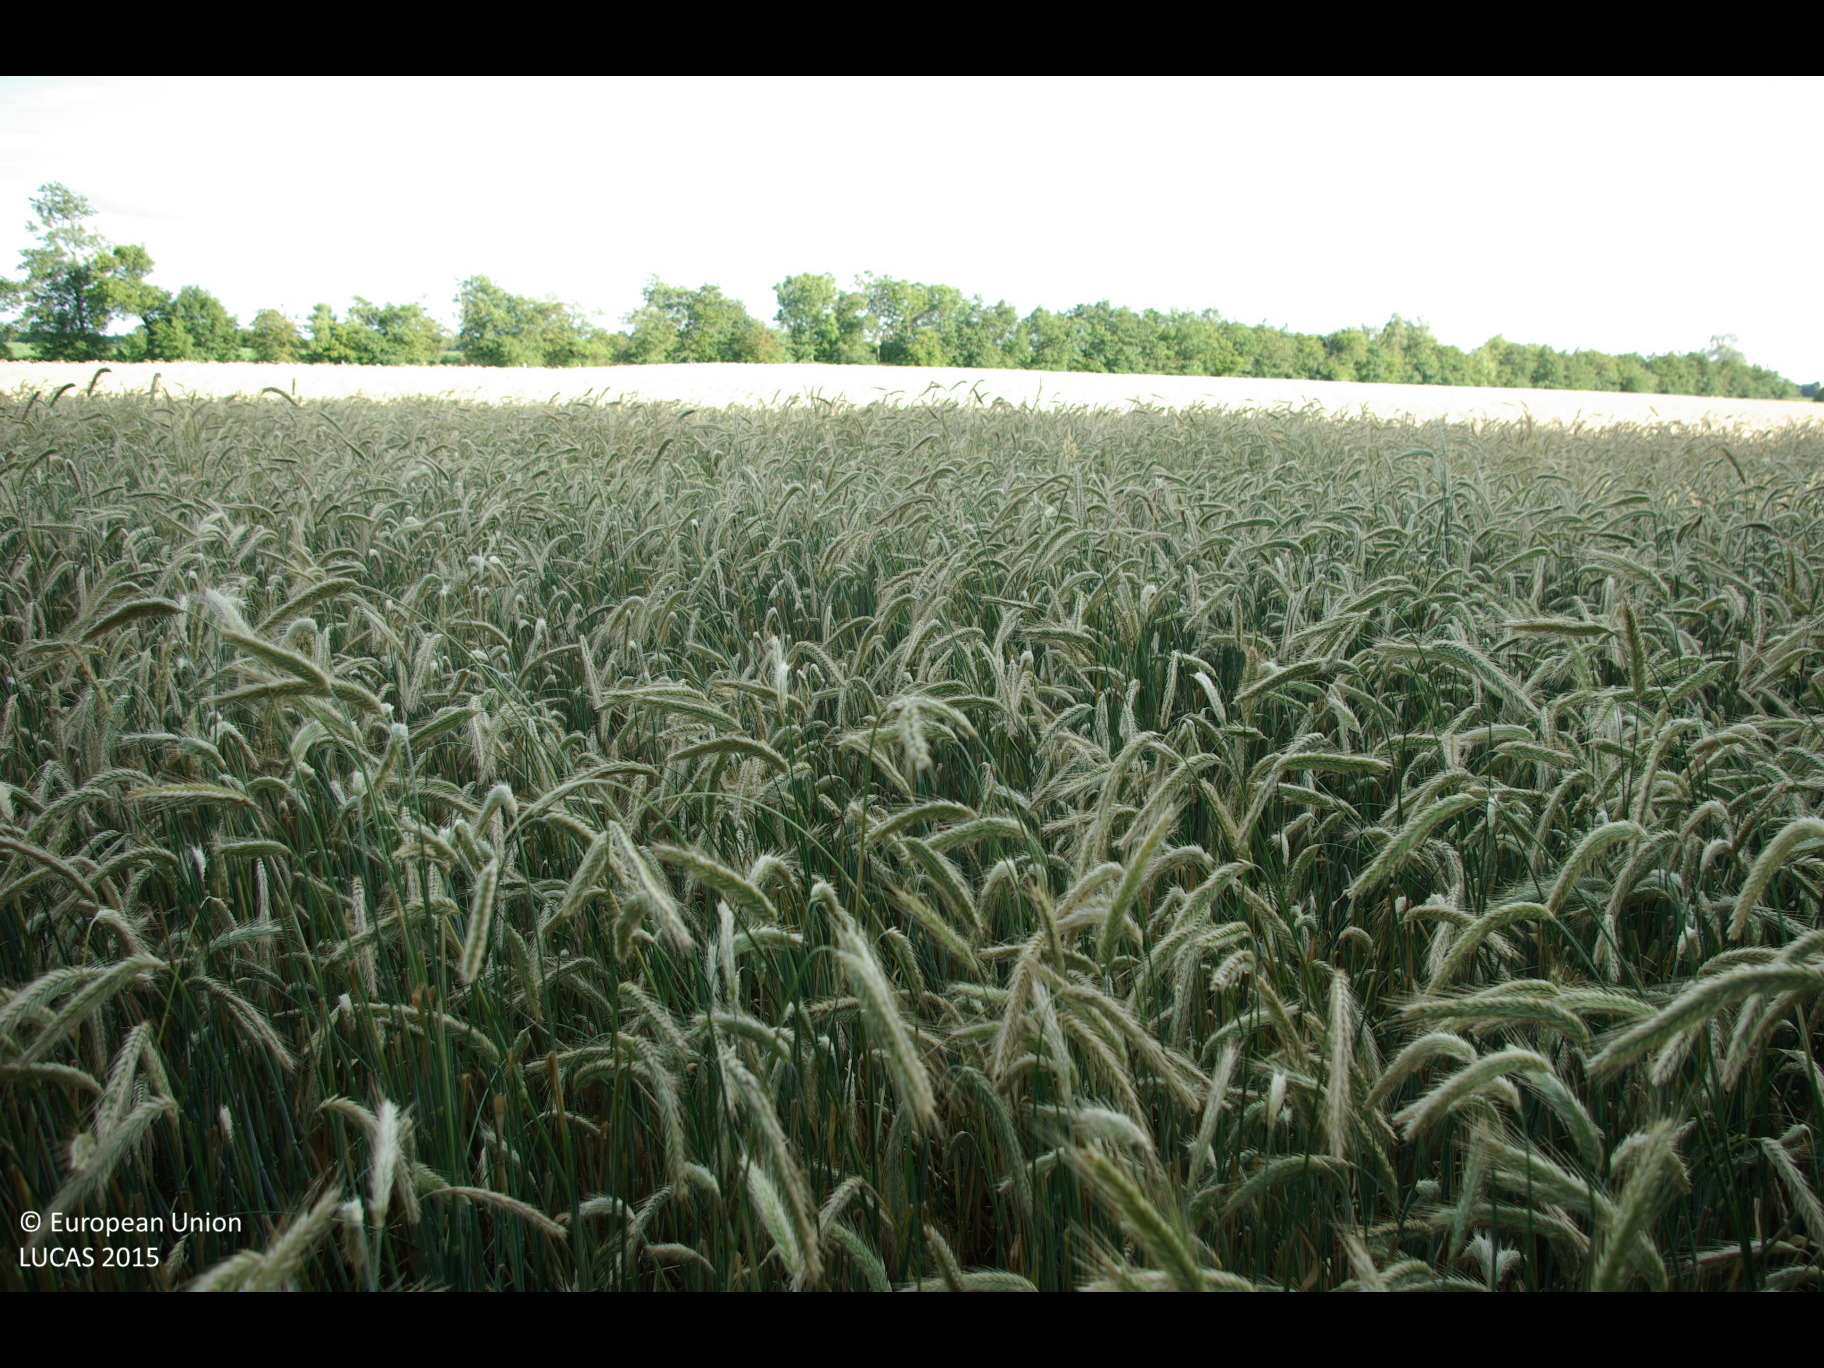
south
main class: Cropland
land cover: Rye
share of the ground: > 75 %
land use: Agriculture (excluding fallow land and kitchen gardens)
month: July
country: DE
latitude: 54.7836
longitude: 9.2697
